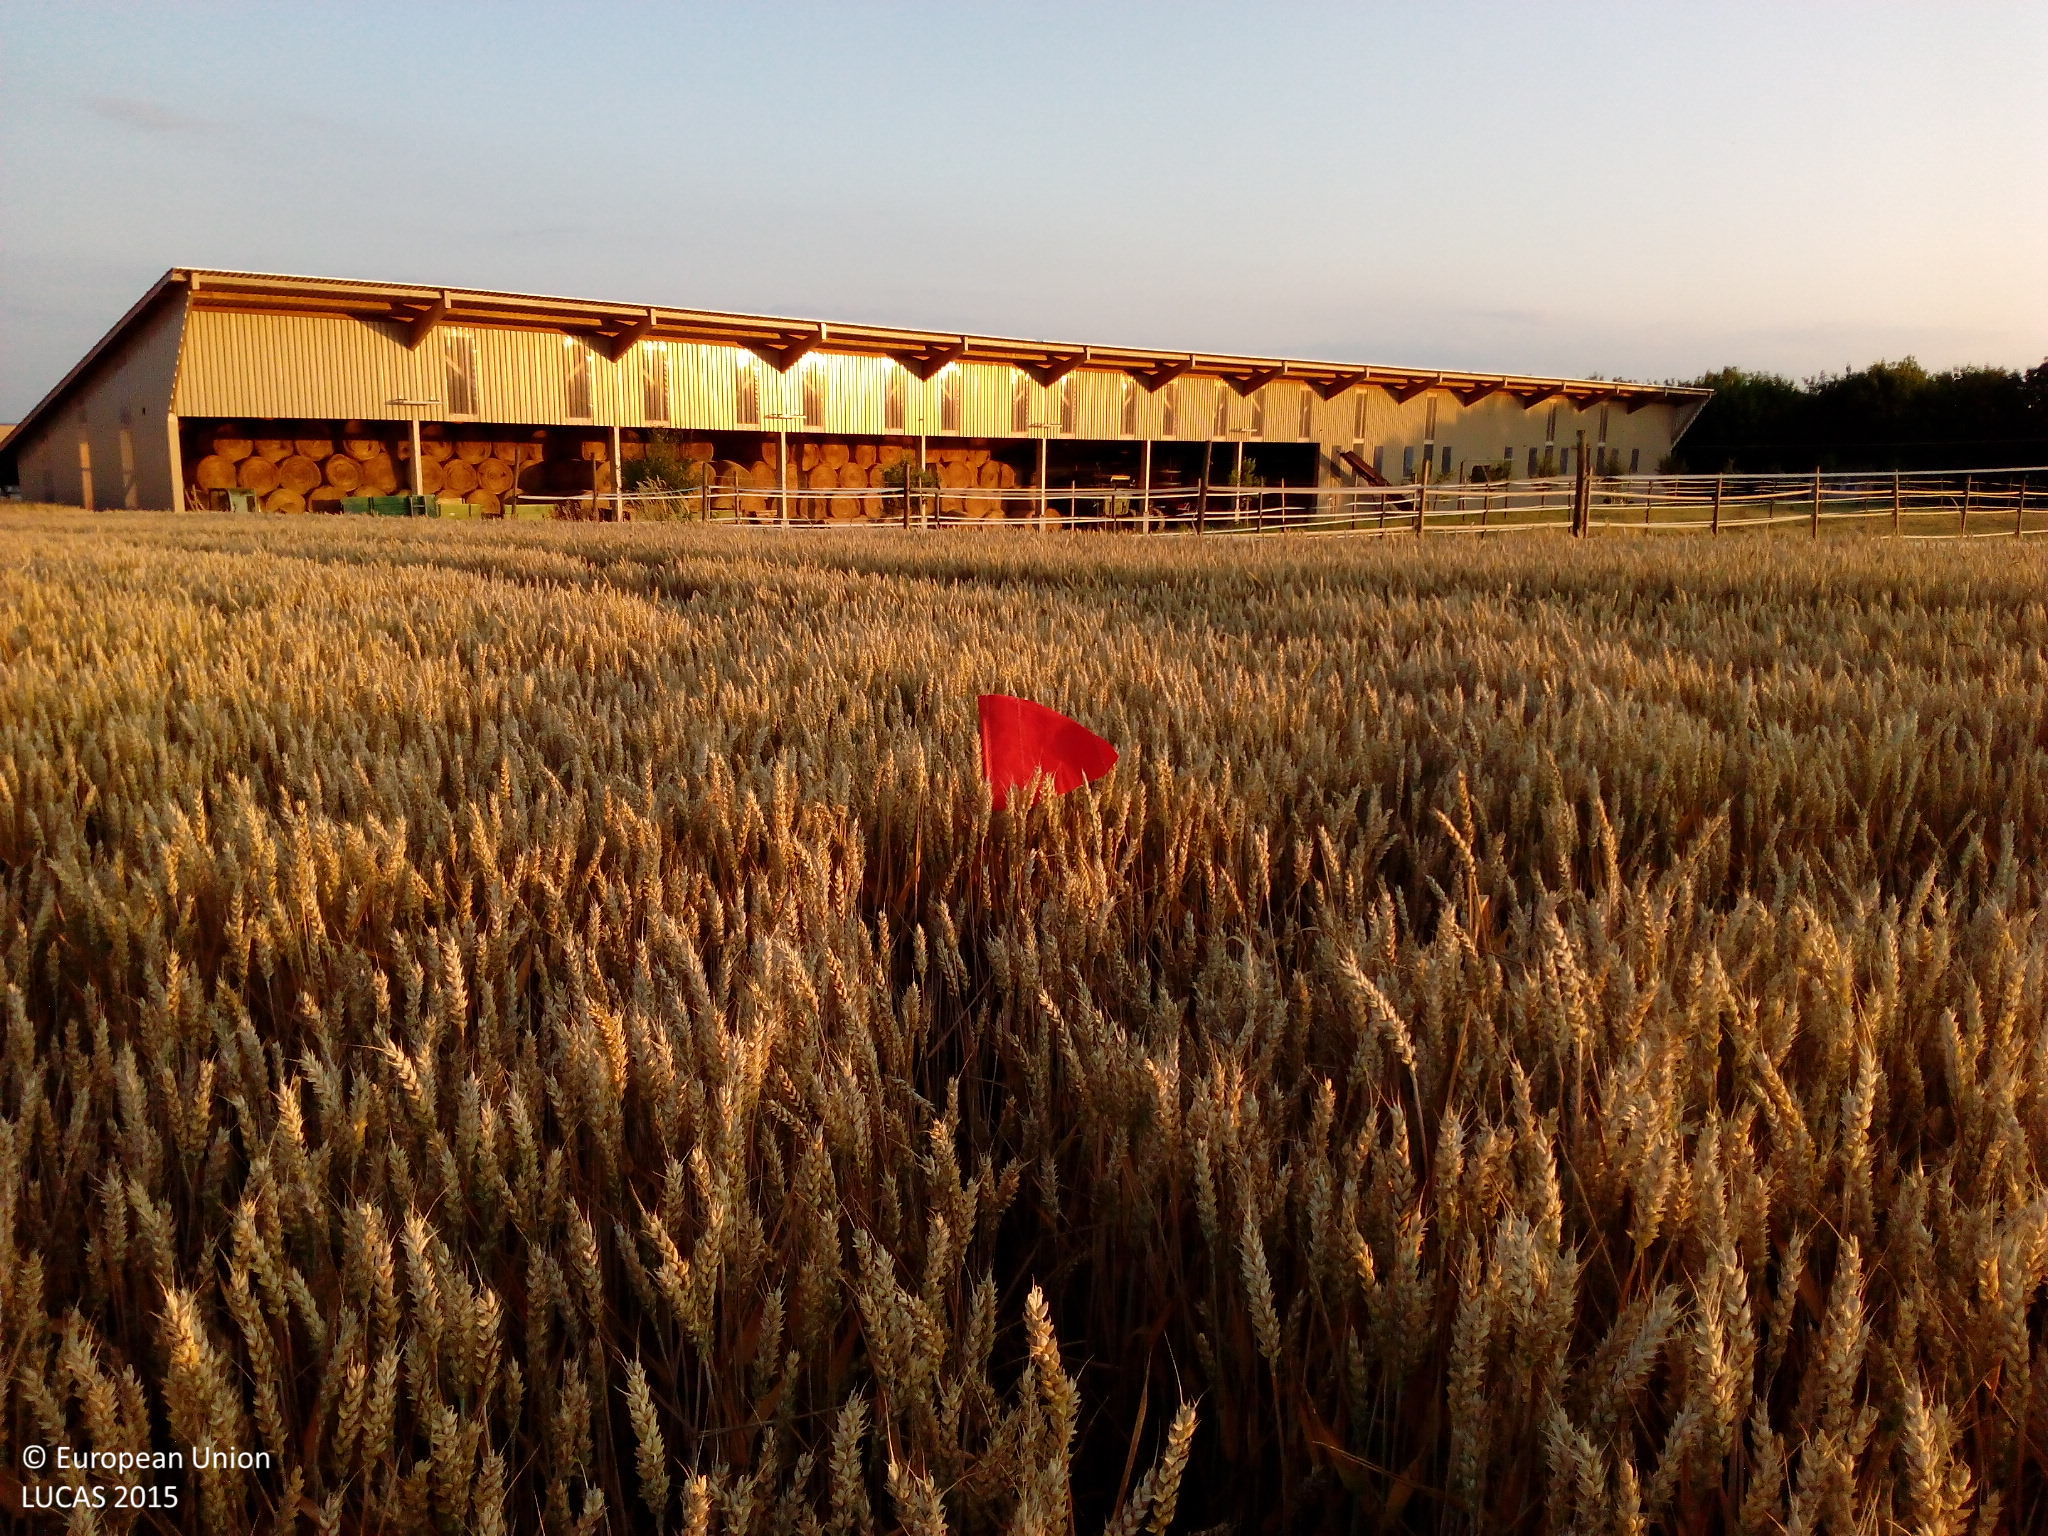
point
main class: Cropland
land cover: Common wheat
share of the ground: > 75 %
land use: Agriculture (excluding fallow land and kitchen gardens)
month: July
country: DE
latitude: 49.6627
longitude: 9.9308
